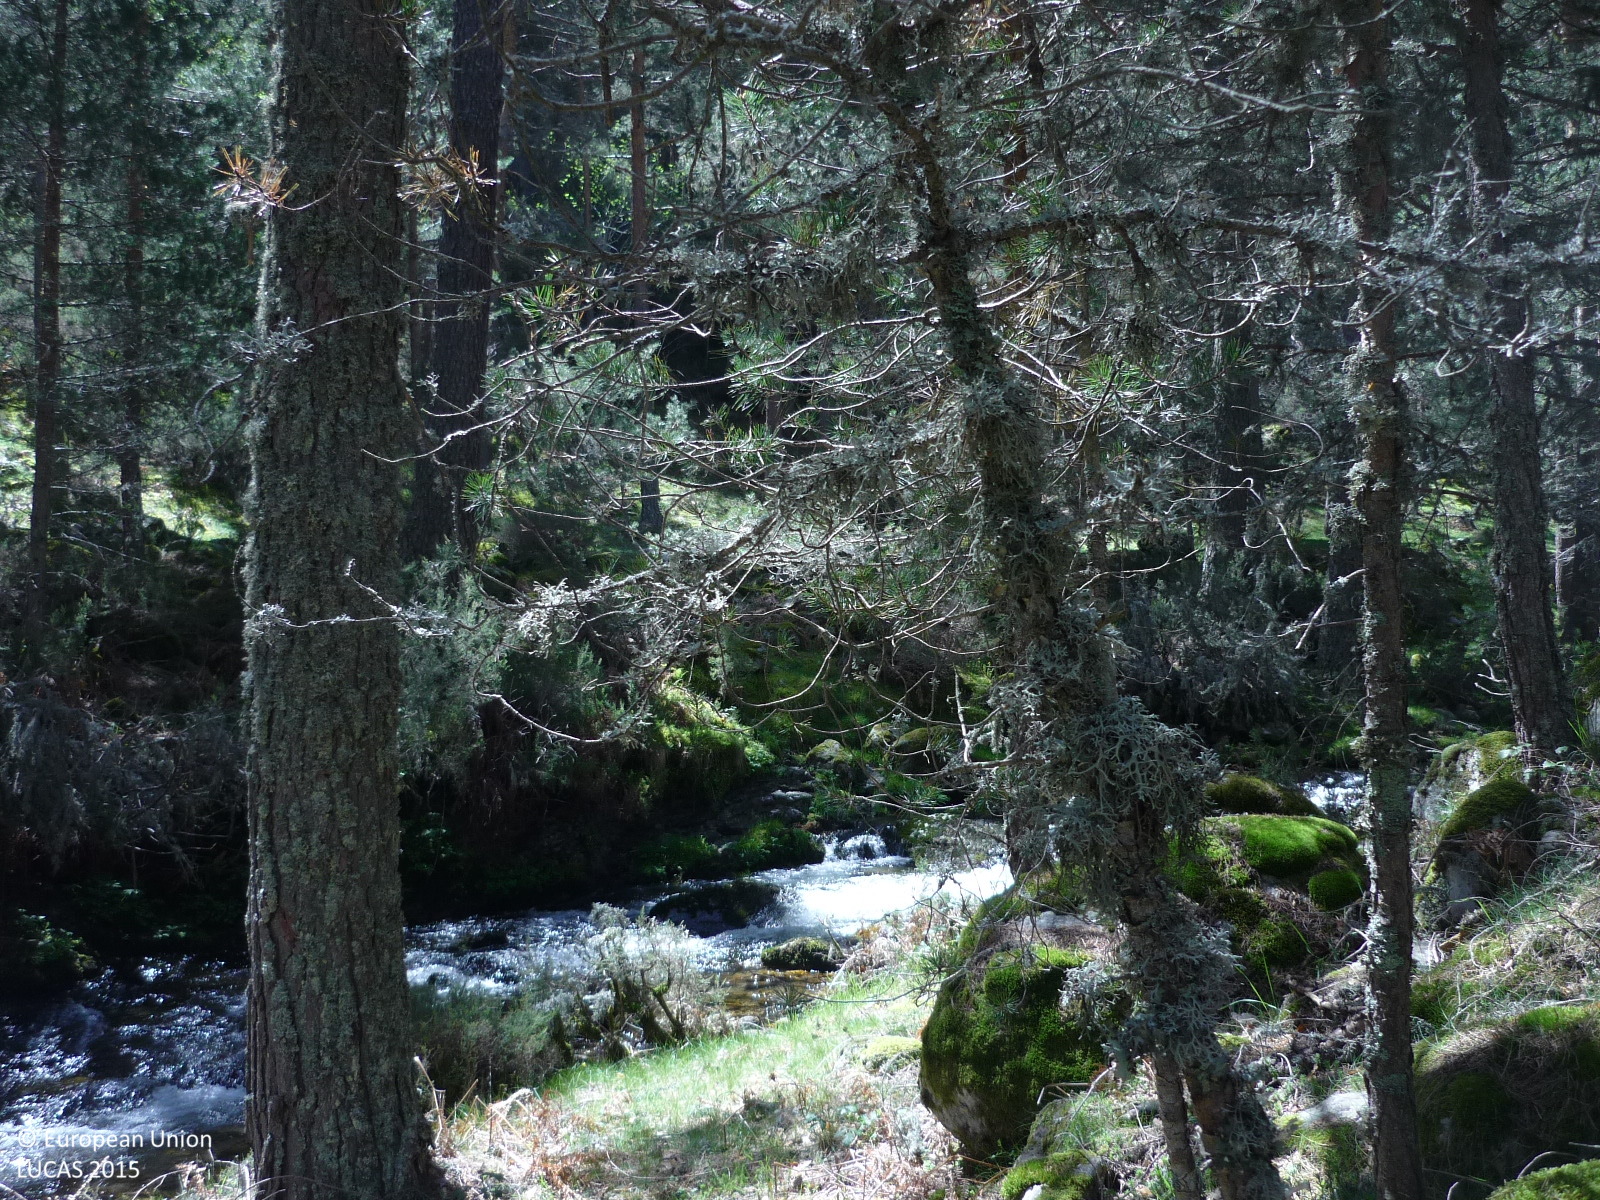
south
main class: Woodland
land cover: Pine dominated coniferous woodland
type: coniferous forest of the mediterranean region
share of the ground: > 75 %
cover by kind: coniferous forest trees 85 %, shrubs 10 %, herbaceous plants 5 %
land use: Forestry
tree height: > 5 m
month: May
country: ES
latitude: 40.8256
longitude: -3.9308
